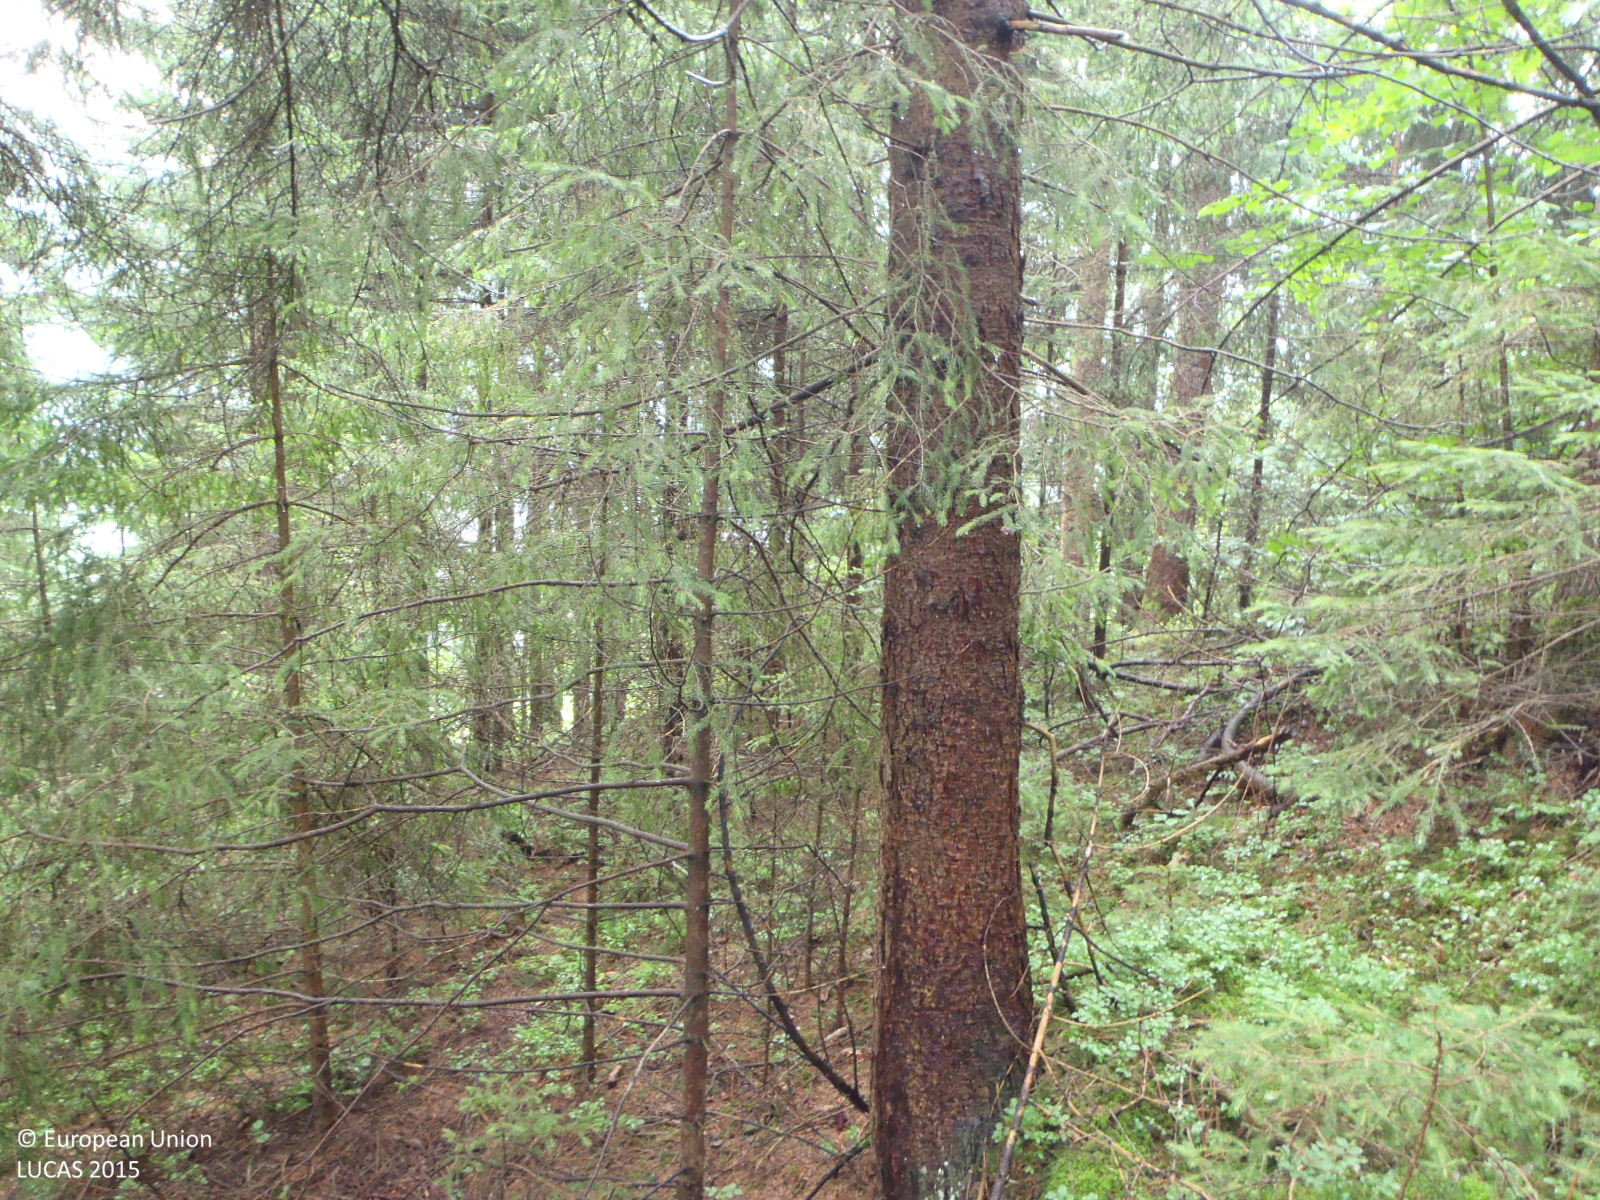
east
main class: Woodland
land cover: Spruce dominated coniferous woodland
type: alpine coniferous forest
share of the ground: > 75 %
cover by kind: coniferous forest trees 85 %, broadleaved forest trees 15 %
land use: Forestry
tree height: > 5 m
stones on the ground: < 10 %
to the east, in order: Spruce dominated coniferous woodland; Broadleaved woodland; Grassland without tree/shrub cover; Paved roads, cycling and walking lanes; Grassland without tree/shrub cover
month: July
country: AT
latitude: 47.2896
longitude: 11.8628
